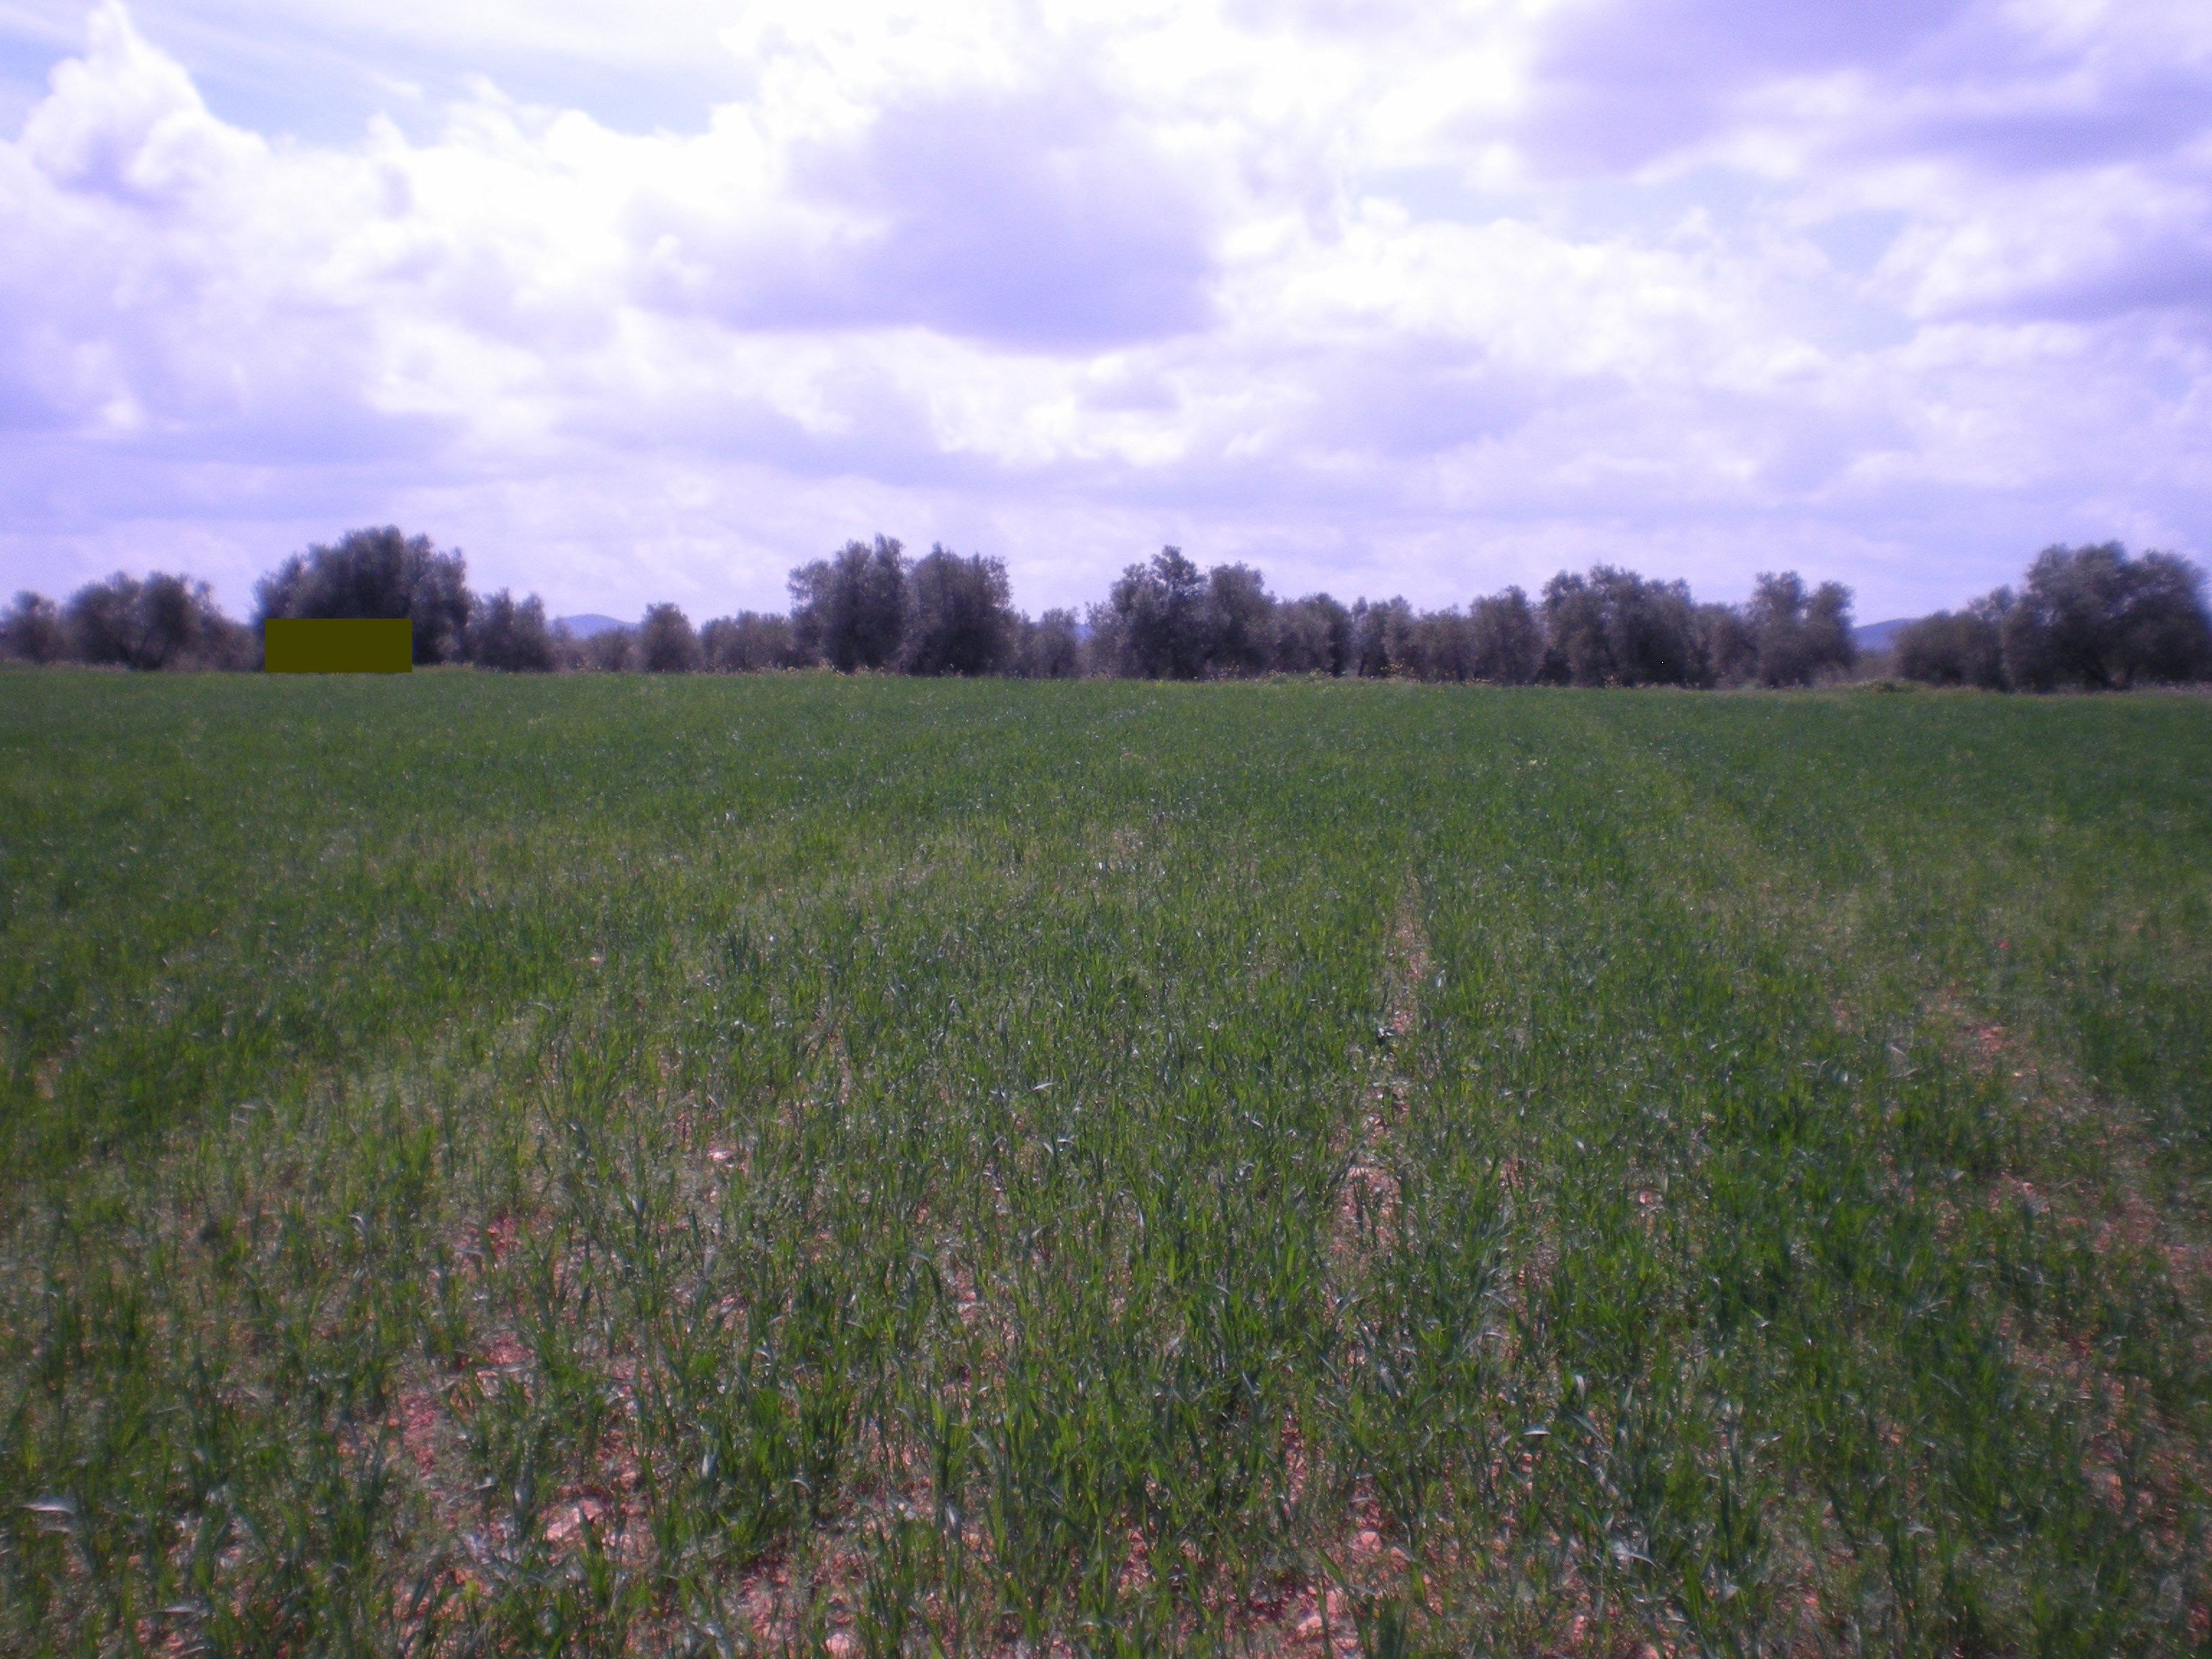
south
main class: Cropland
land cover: Barley
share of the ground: 50 - 75 %
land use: Agriculture (excluding fallow land and kitchen gardens)
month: April
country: ES
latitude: 38.6887
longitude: -3.4965
